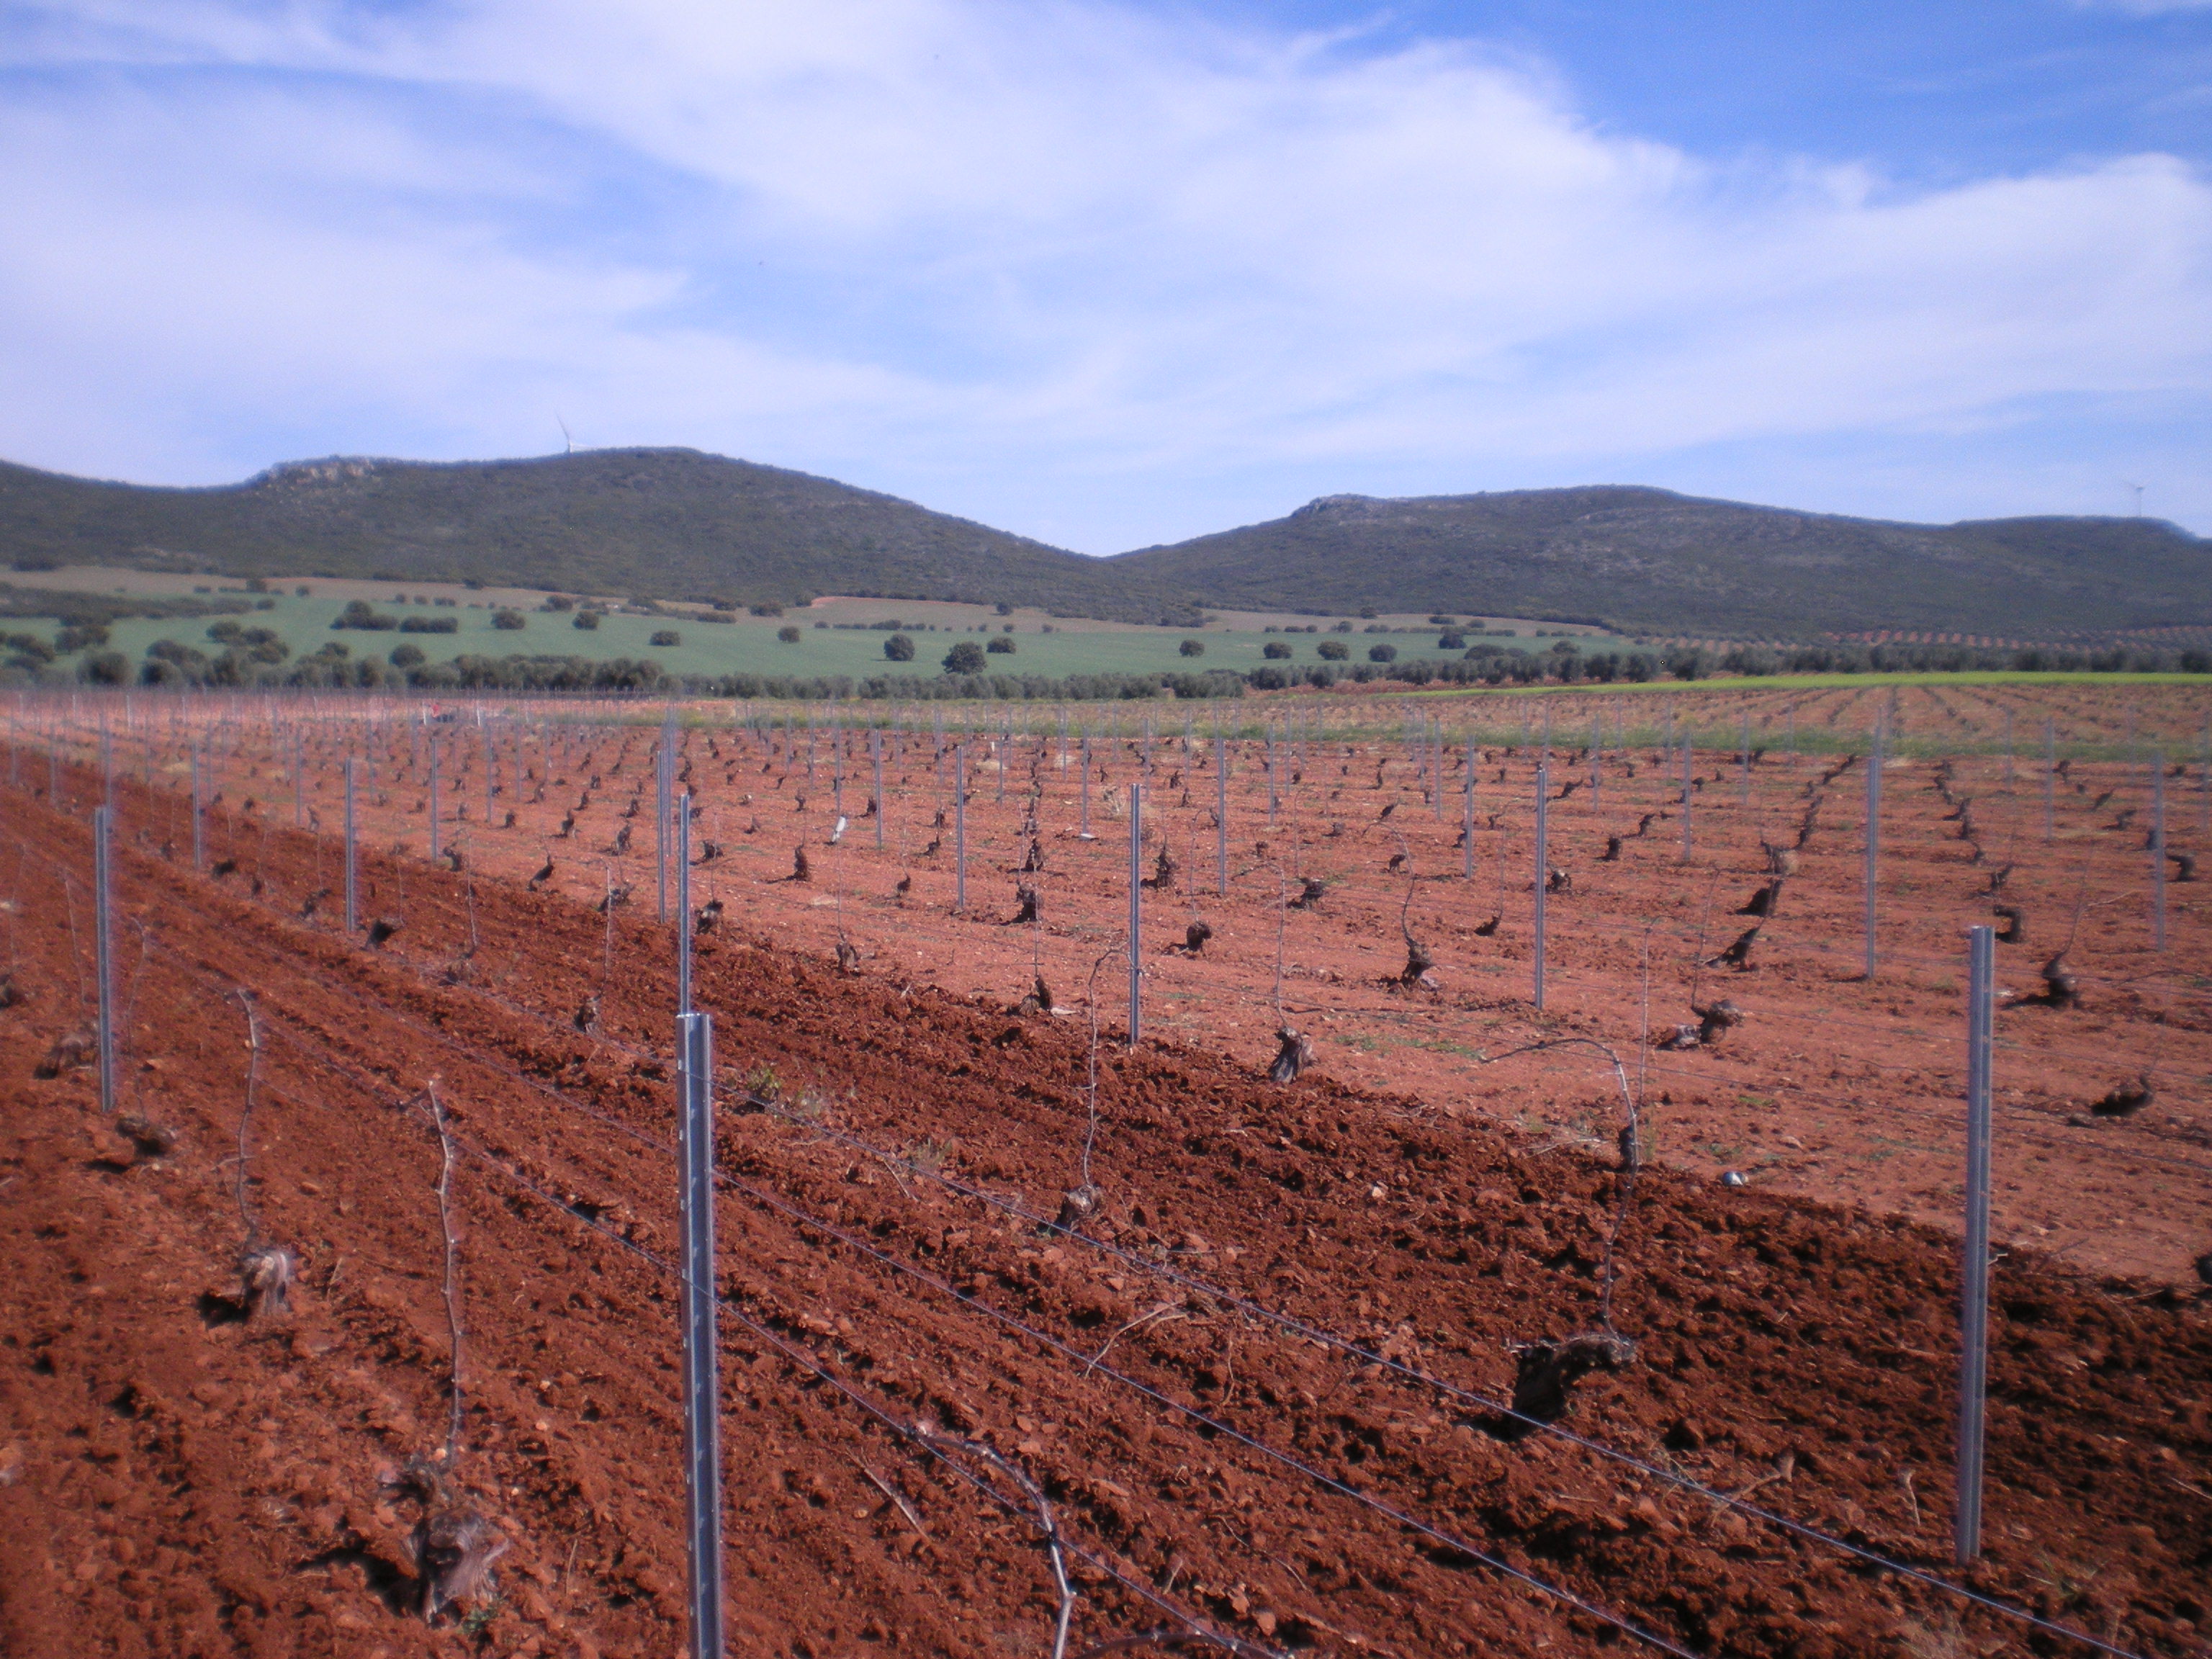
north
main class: Cropland
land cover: Vineyards
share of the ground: < 10 %
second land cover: Other bare soil
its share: > 75 %
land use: Agriculture (excluding fallow land and kitchen gardens)
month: April
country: ES
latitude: 38.8220
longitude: -3.1979
